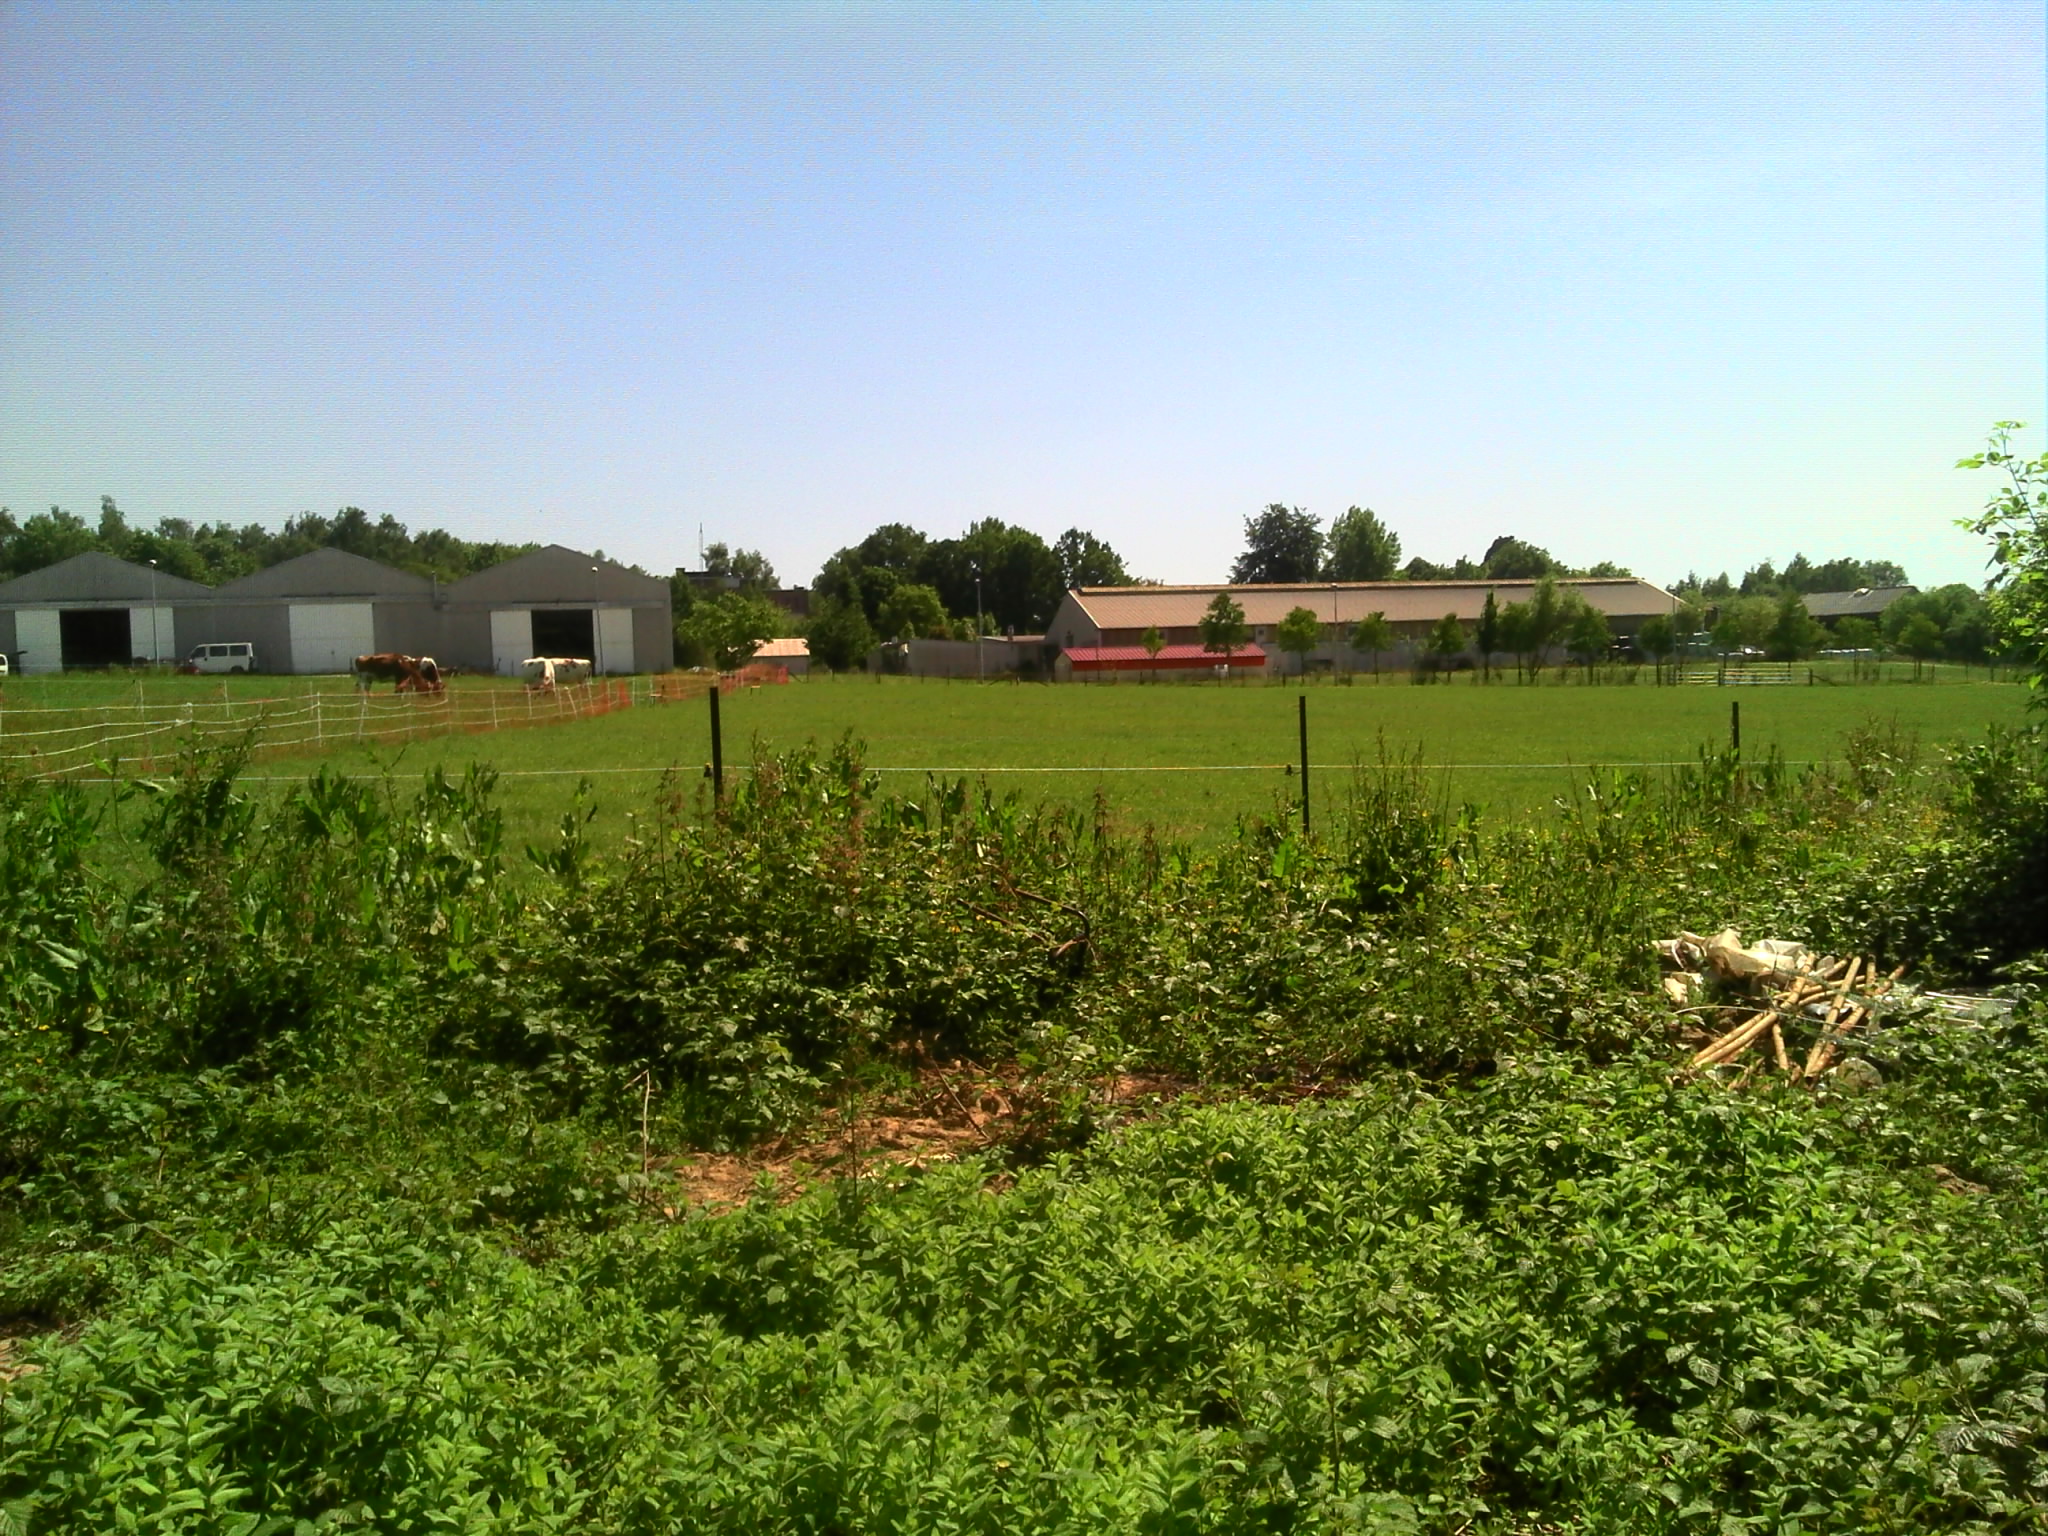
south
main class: Grassland
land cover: Spontaneously vegetated surfaces
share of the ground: 50 - 75 %
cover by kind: herbaceous plants 55 %, unconsolidated bare surface 40 %, shrubs 5 %
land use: Abandoned areas
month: June
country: BE
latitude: 50.5657
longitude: 4.7021
